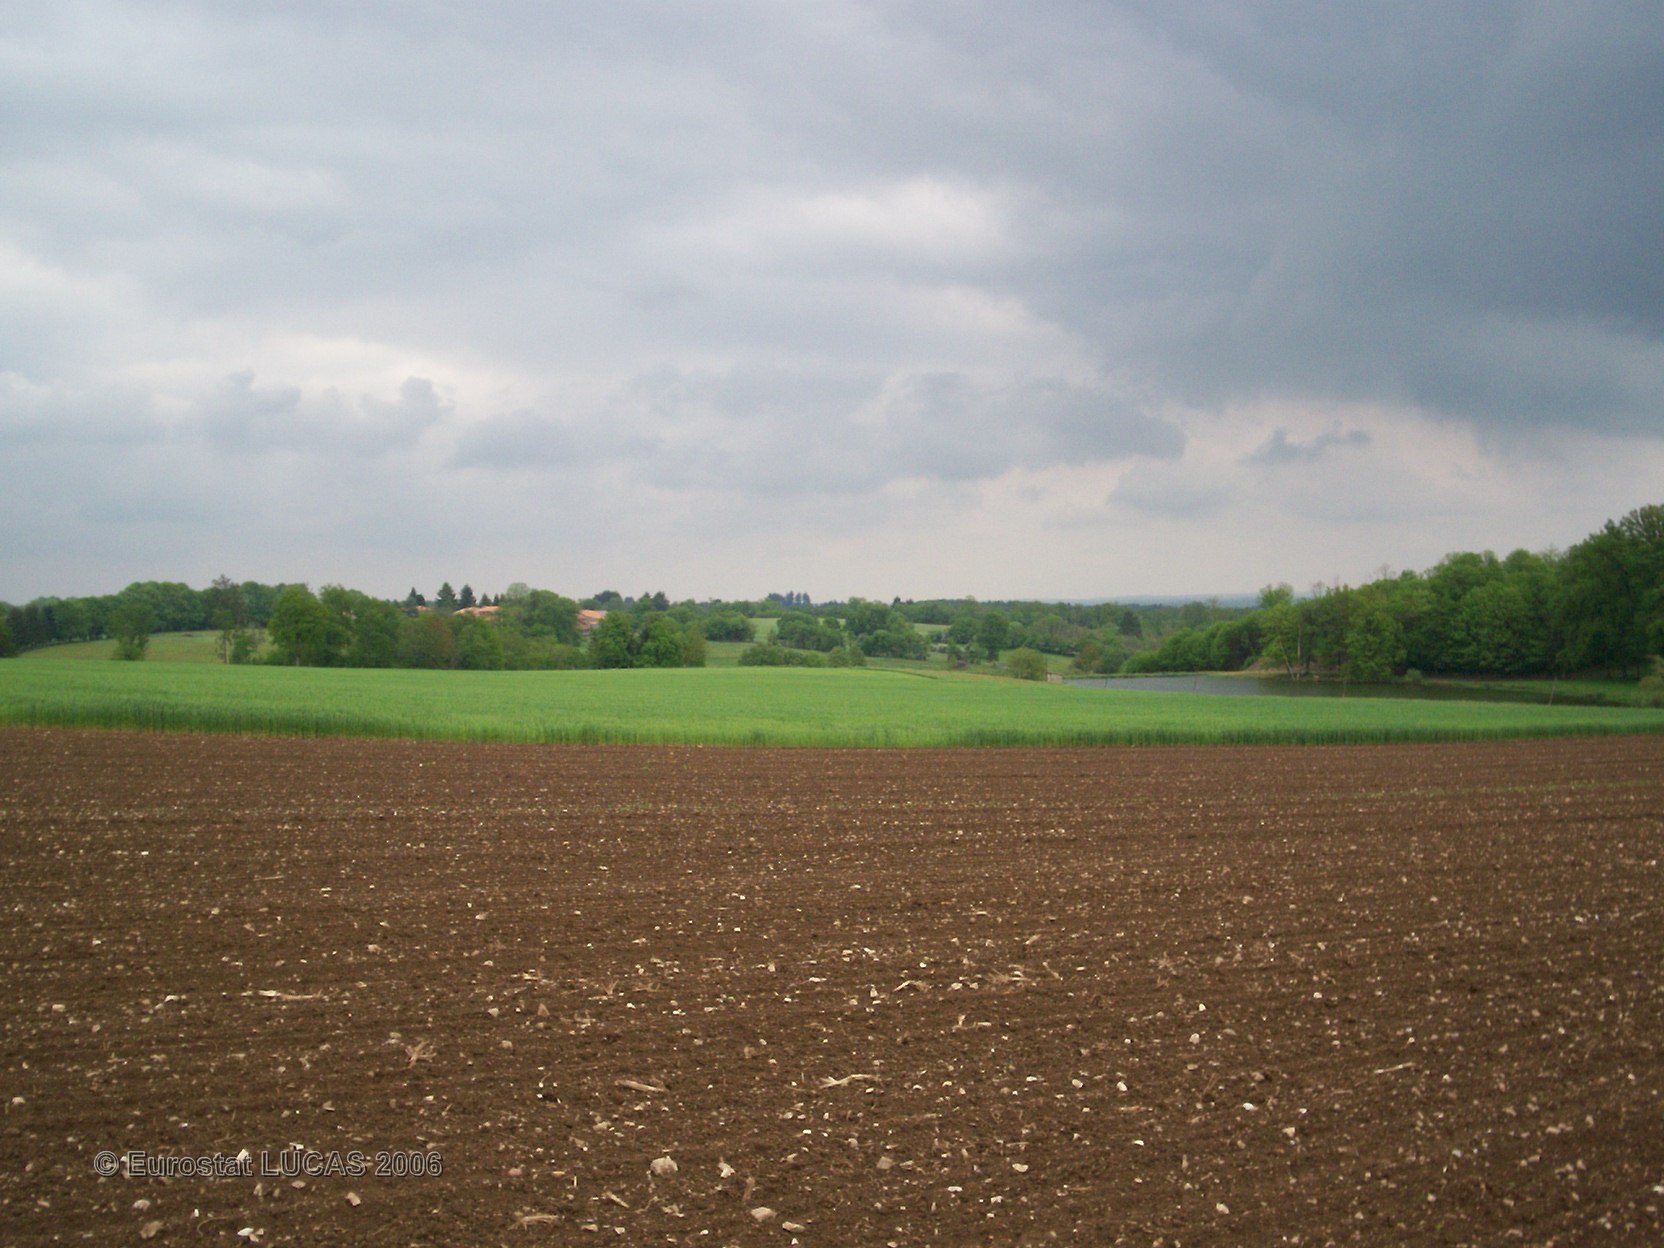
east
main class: Cropland
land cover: Maize
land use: Agriculture (excluding fallow land and kitchen gardens)
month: May
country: FR
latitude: 45.7340
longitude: 0.5667
